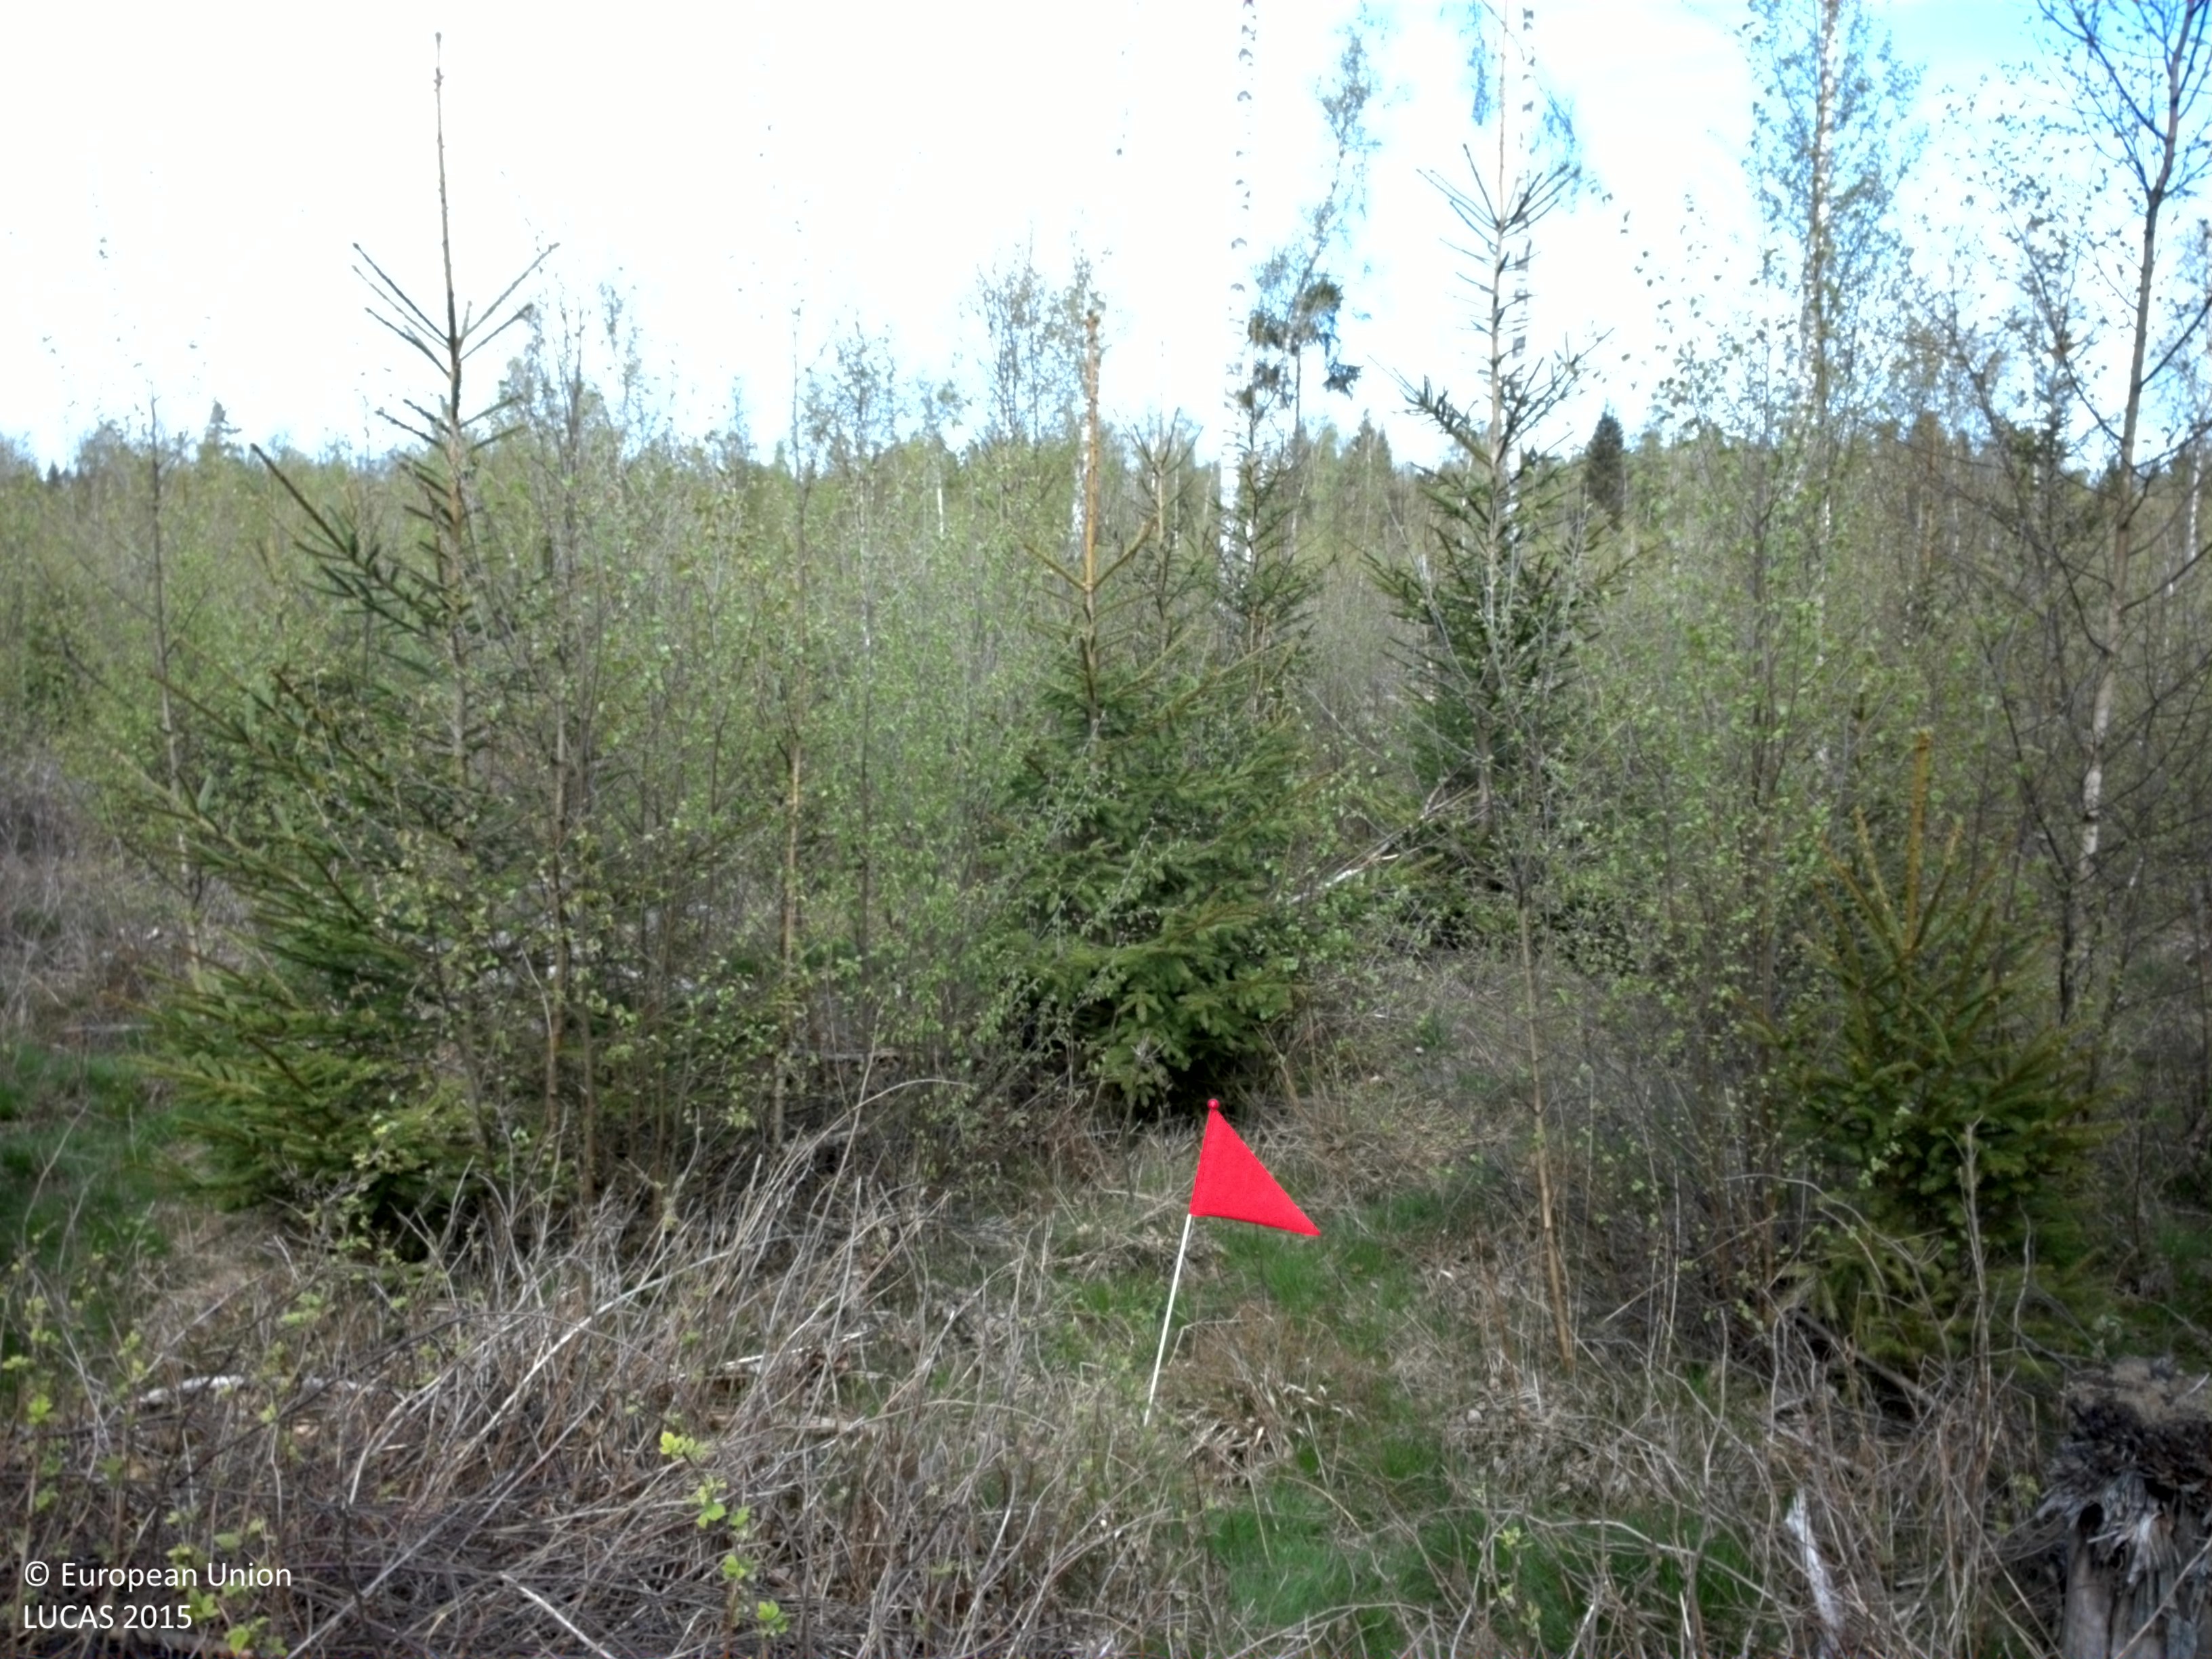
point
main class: Woodland
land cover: Spruce dominated mixed woodland
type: boreal forest
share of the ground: 50 - 75 %
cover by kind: broadleaved forest trees 40 %, coniferous forest trees 30 %, herbaceous plants 15 %, lichens and mosses 15 %
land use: Forestry
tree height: > 5 m
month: May
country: SE
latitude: 56.6931
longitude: 14.7817
